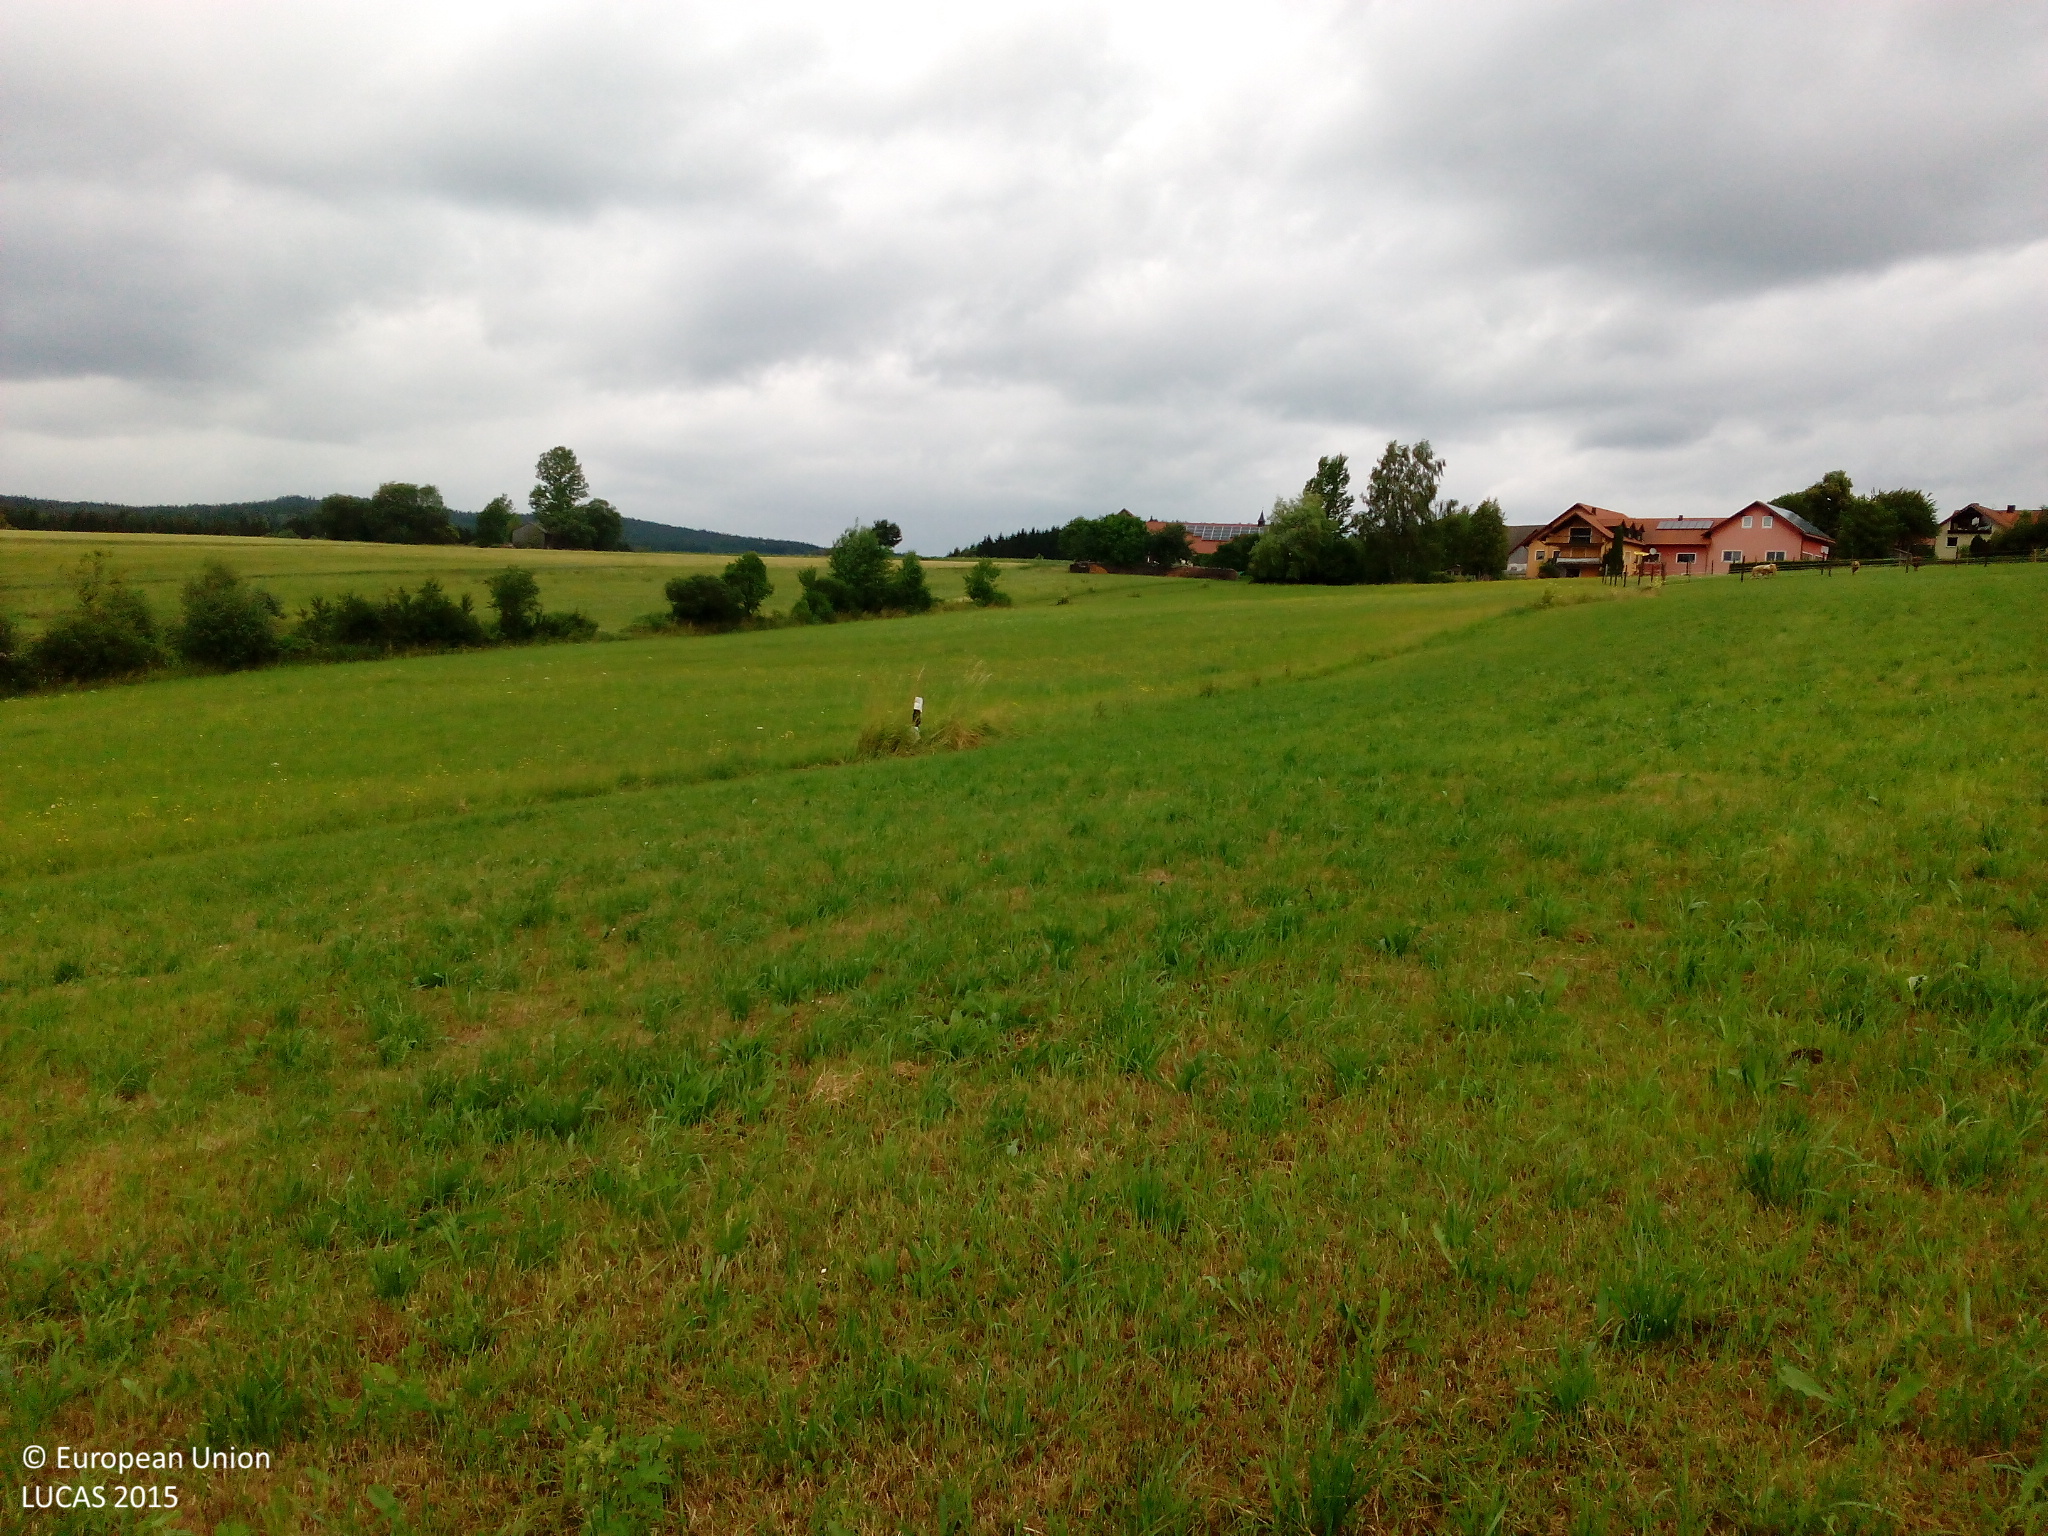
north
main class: Grassland
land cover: Grassland without tree/shrub cover
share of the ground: > 75 %
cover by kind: herbaceous plants 75 %, unconsolidated bare surface 5 %
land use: Agriculture (excluding fallow land and kitchen gardens)
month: July
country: DE
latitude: 49.4924
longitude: 12.4432
